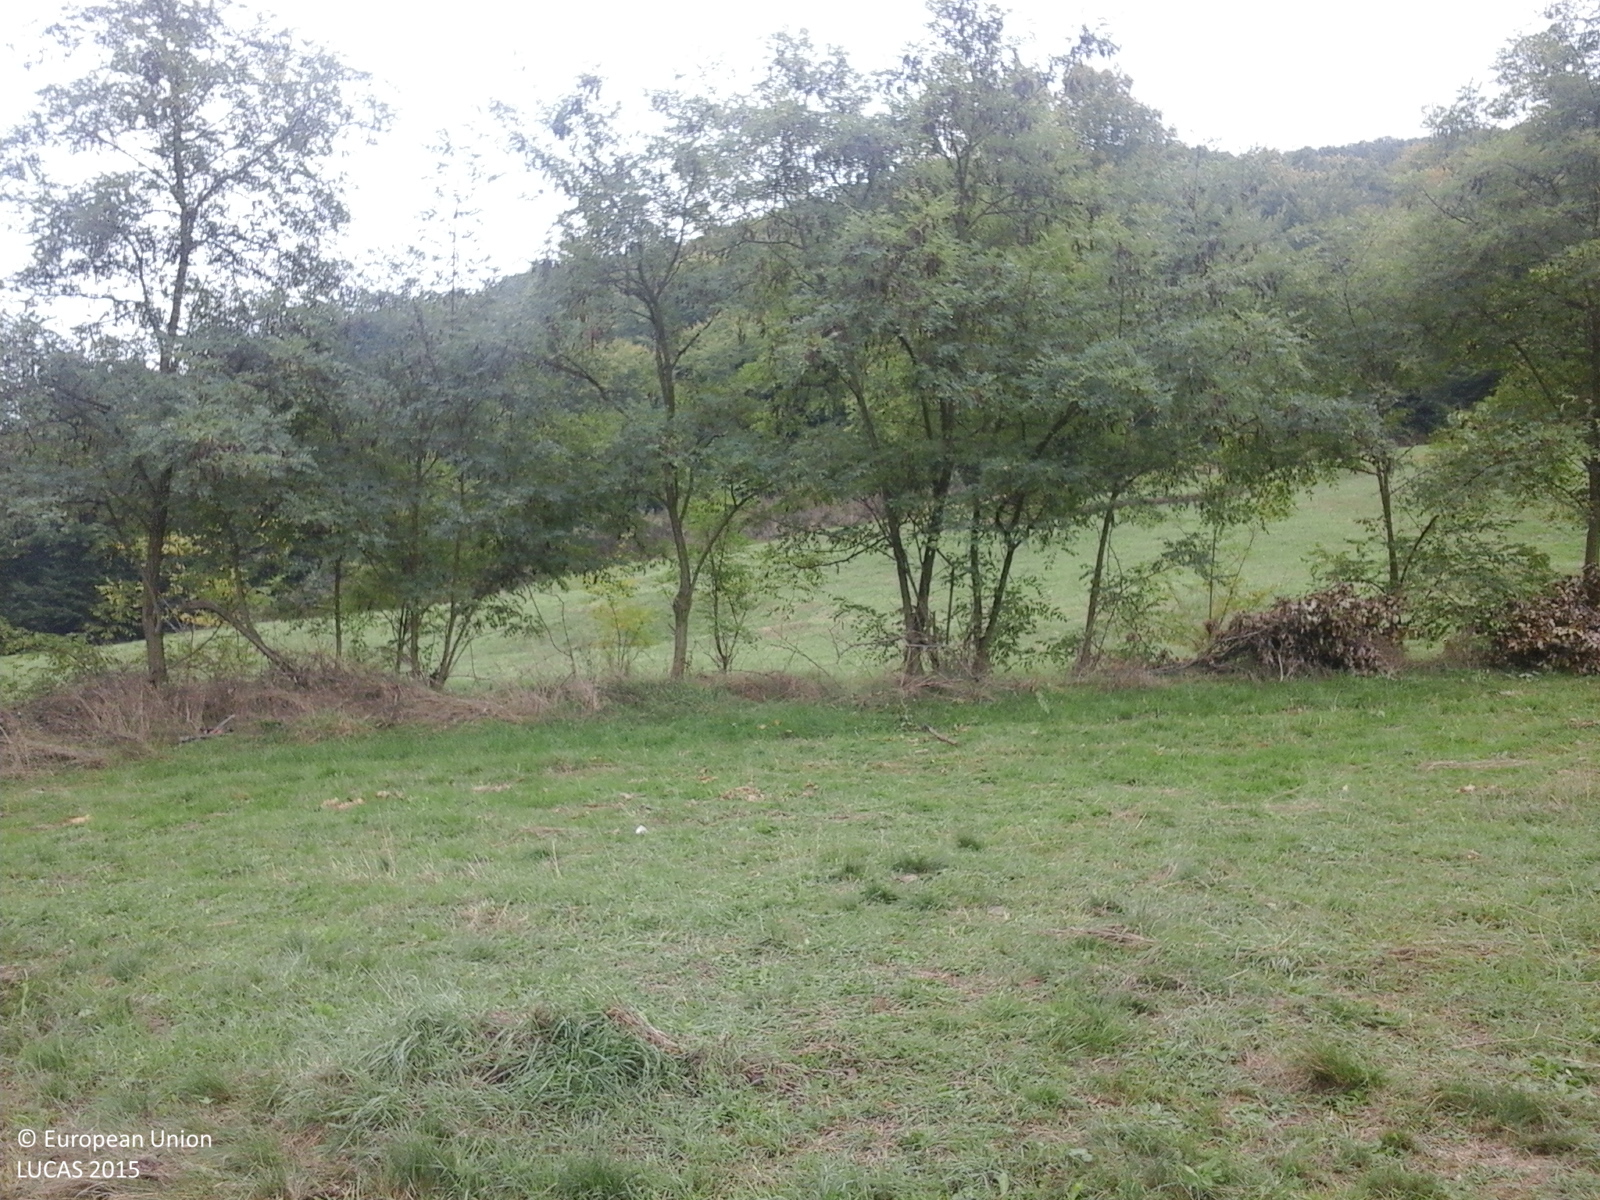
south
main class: Grassland
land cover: Grassland without tree/shrub cover
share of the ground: > 75 %
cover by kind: herbaceous plants 100 %
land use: Agriculture (excluding fallow land and kitchen gardens)
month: October
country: RO
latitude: 46.0990
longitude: 23.4526
